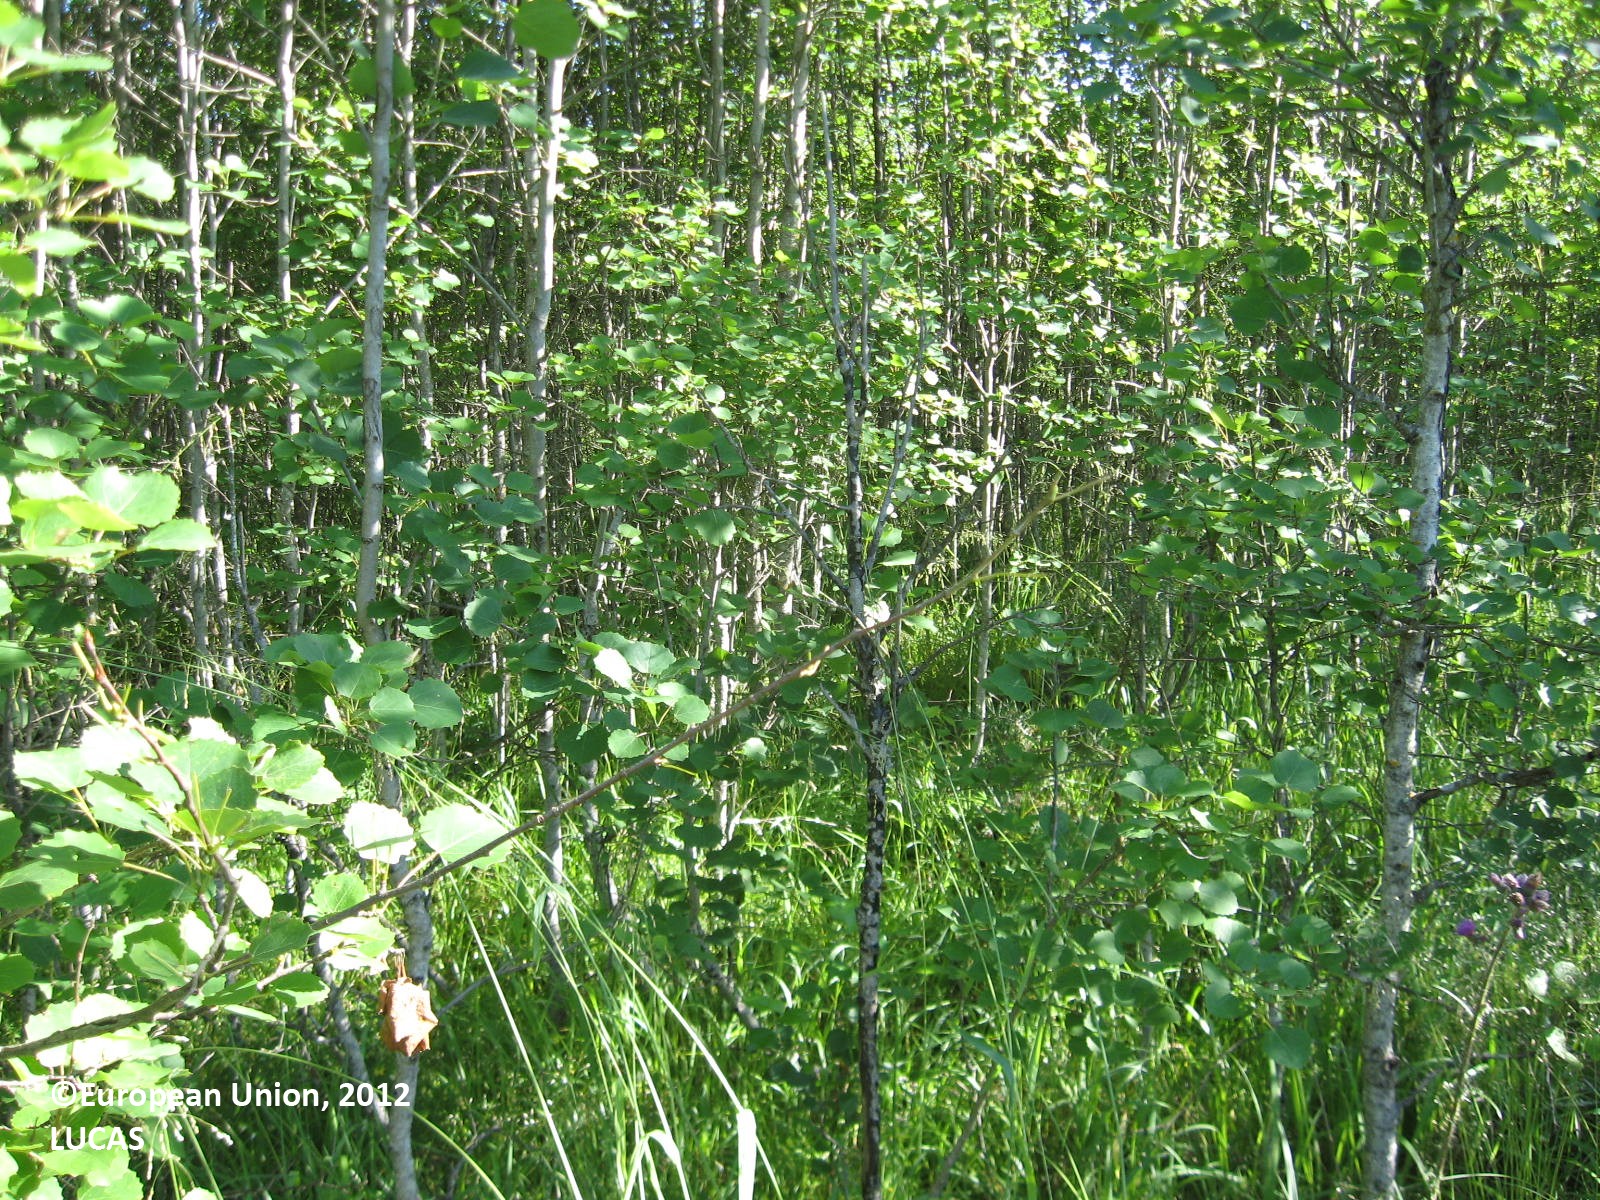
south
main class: Woodland
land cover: Broadleaved woodland
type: boreal forest
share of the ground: > 75 %
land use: Forestry
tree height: > 5 m
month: July
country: FI
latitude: 62.1400
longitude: 21.4199
